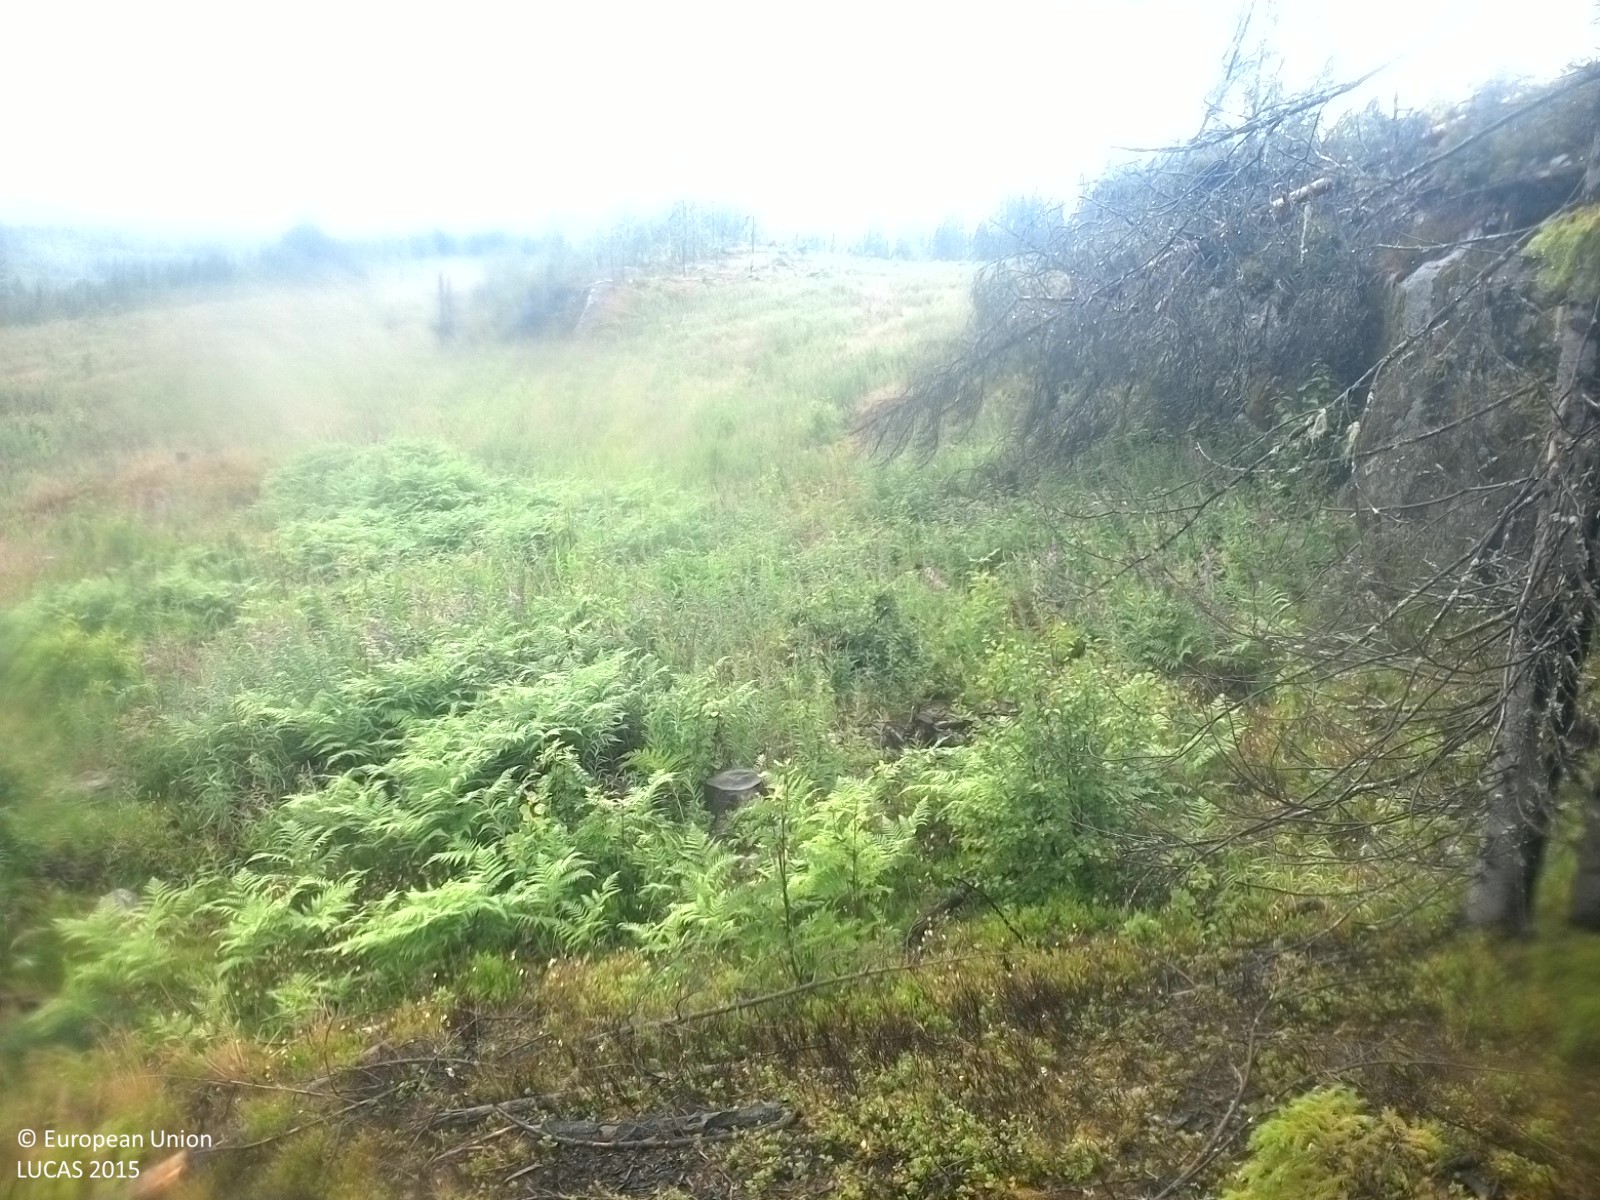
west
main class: Woodland
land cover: Other mixed woodland
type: boreal forest
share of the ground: 25 - 50 %
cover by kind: broadleaved forest trees 25 %, herbaceous plants 25 %, shrubs 20 %, lichens and mosses 20 %, coniferous forest trees 10 %
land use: Forestry
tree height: < 5 m
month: July
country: SE
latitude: 62.4112
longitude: 17.0446
